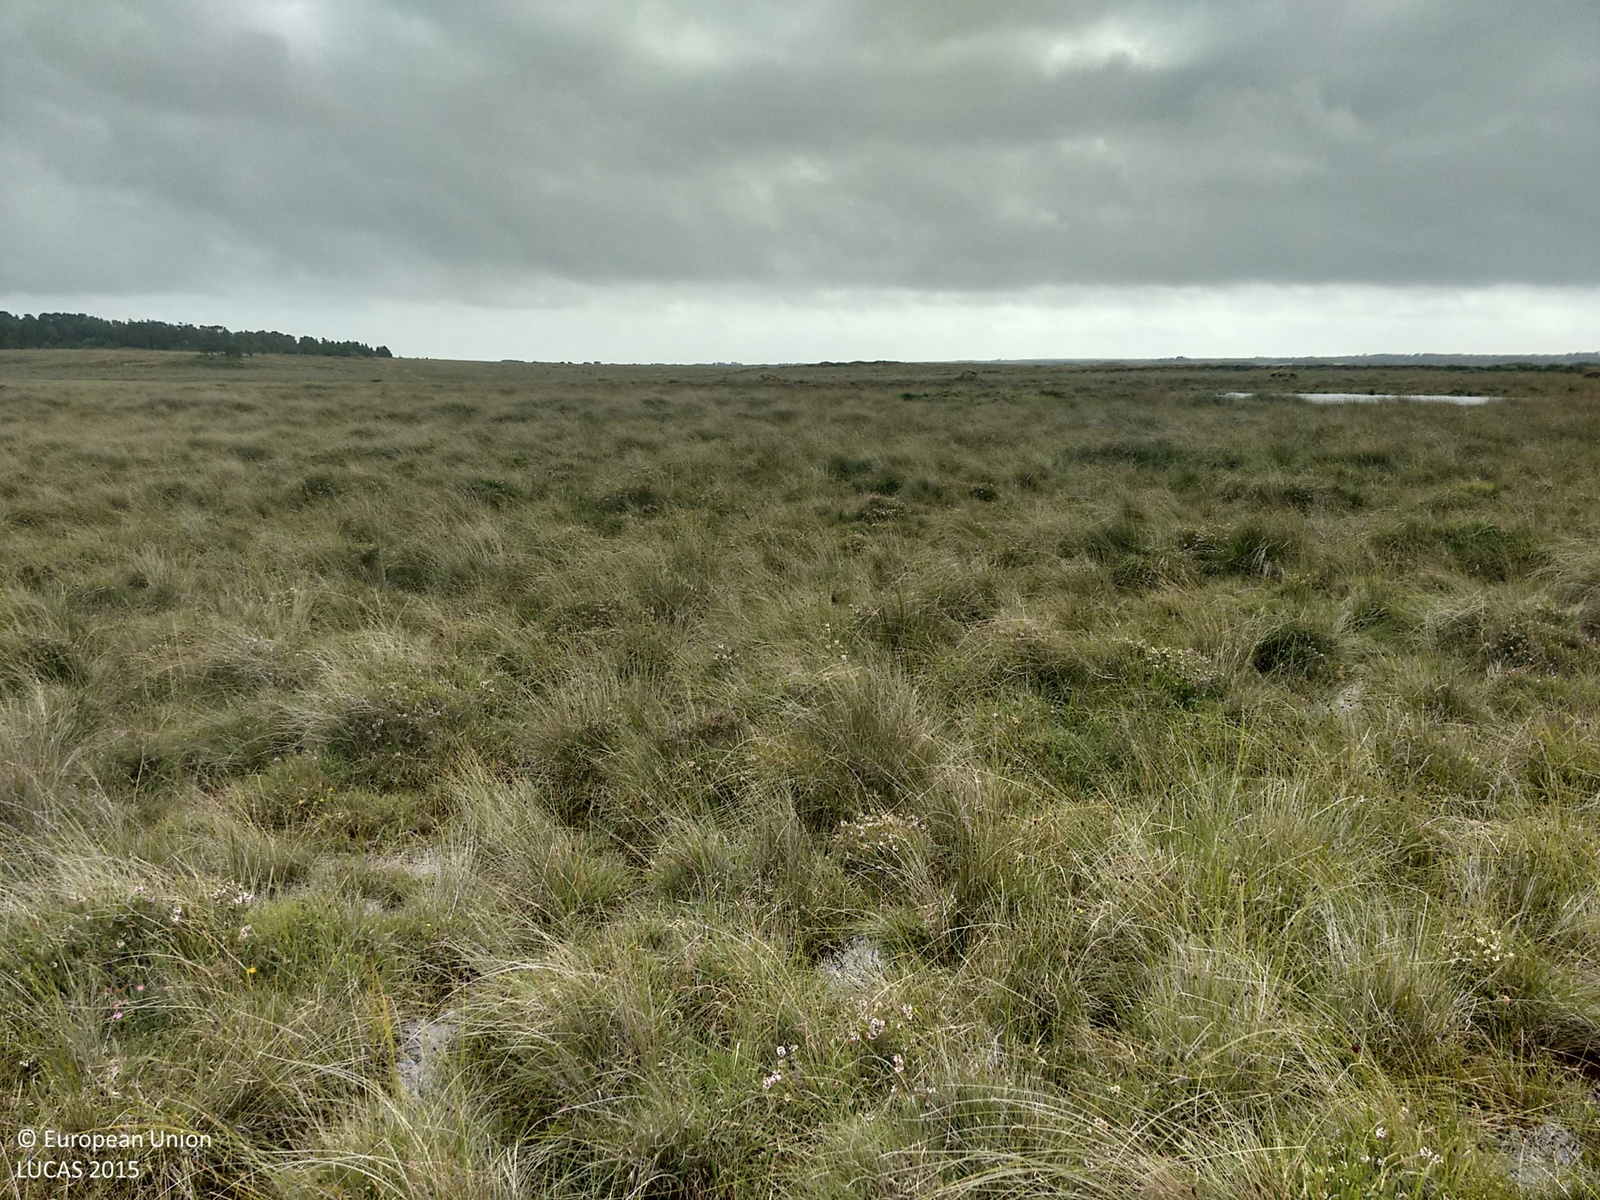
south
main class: Grassland
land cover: Grassland without tree/shrub cover
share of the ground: > 75 %
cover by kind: herbaceous plants 100 %
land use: Agriculture (excluding fallow land and kitchen gardens)
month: August
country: GB
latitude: 50.0378
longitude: -5.1846
